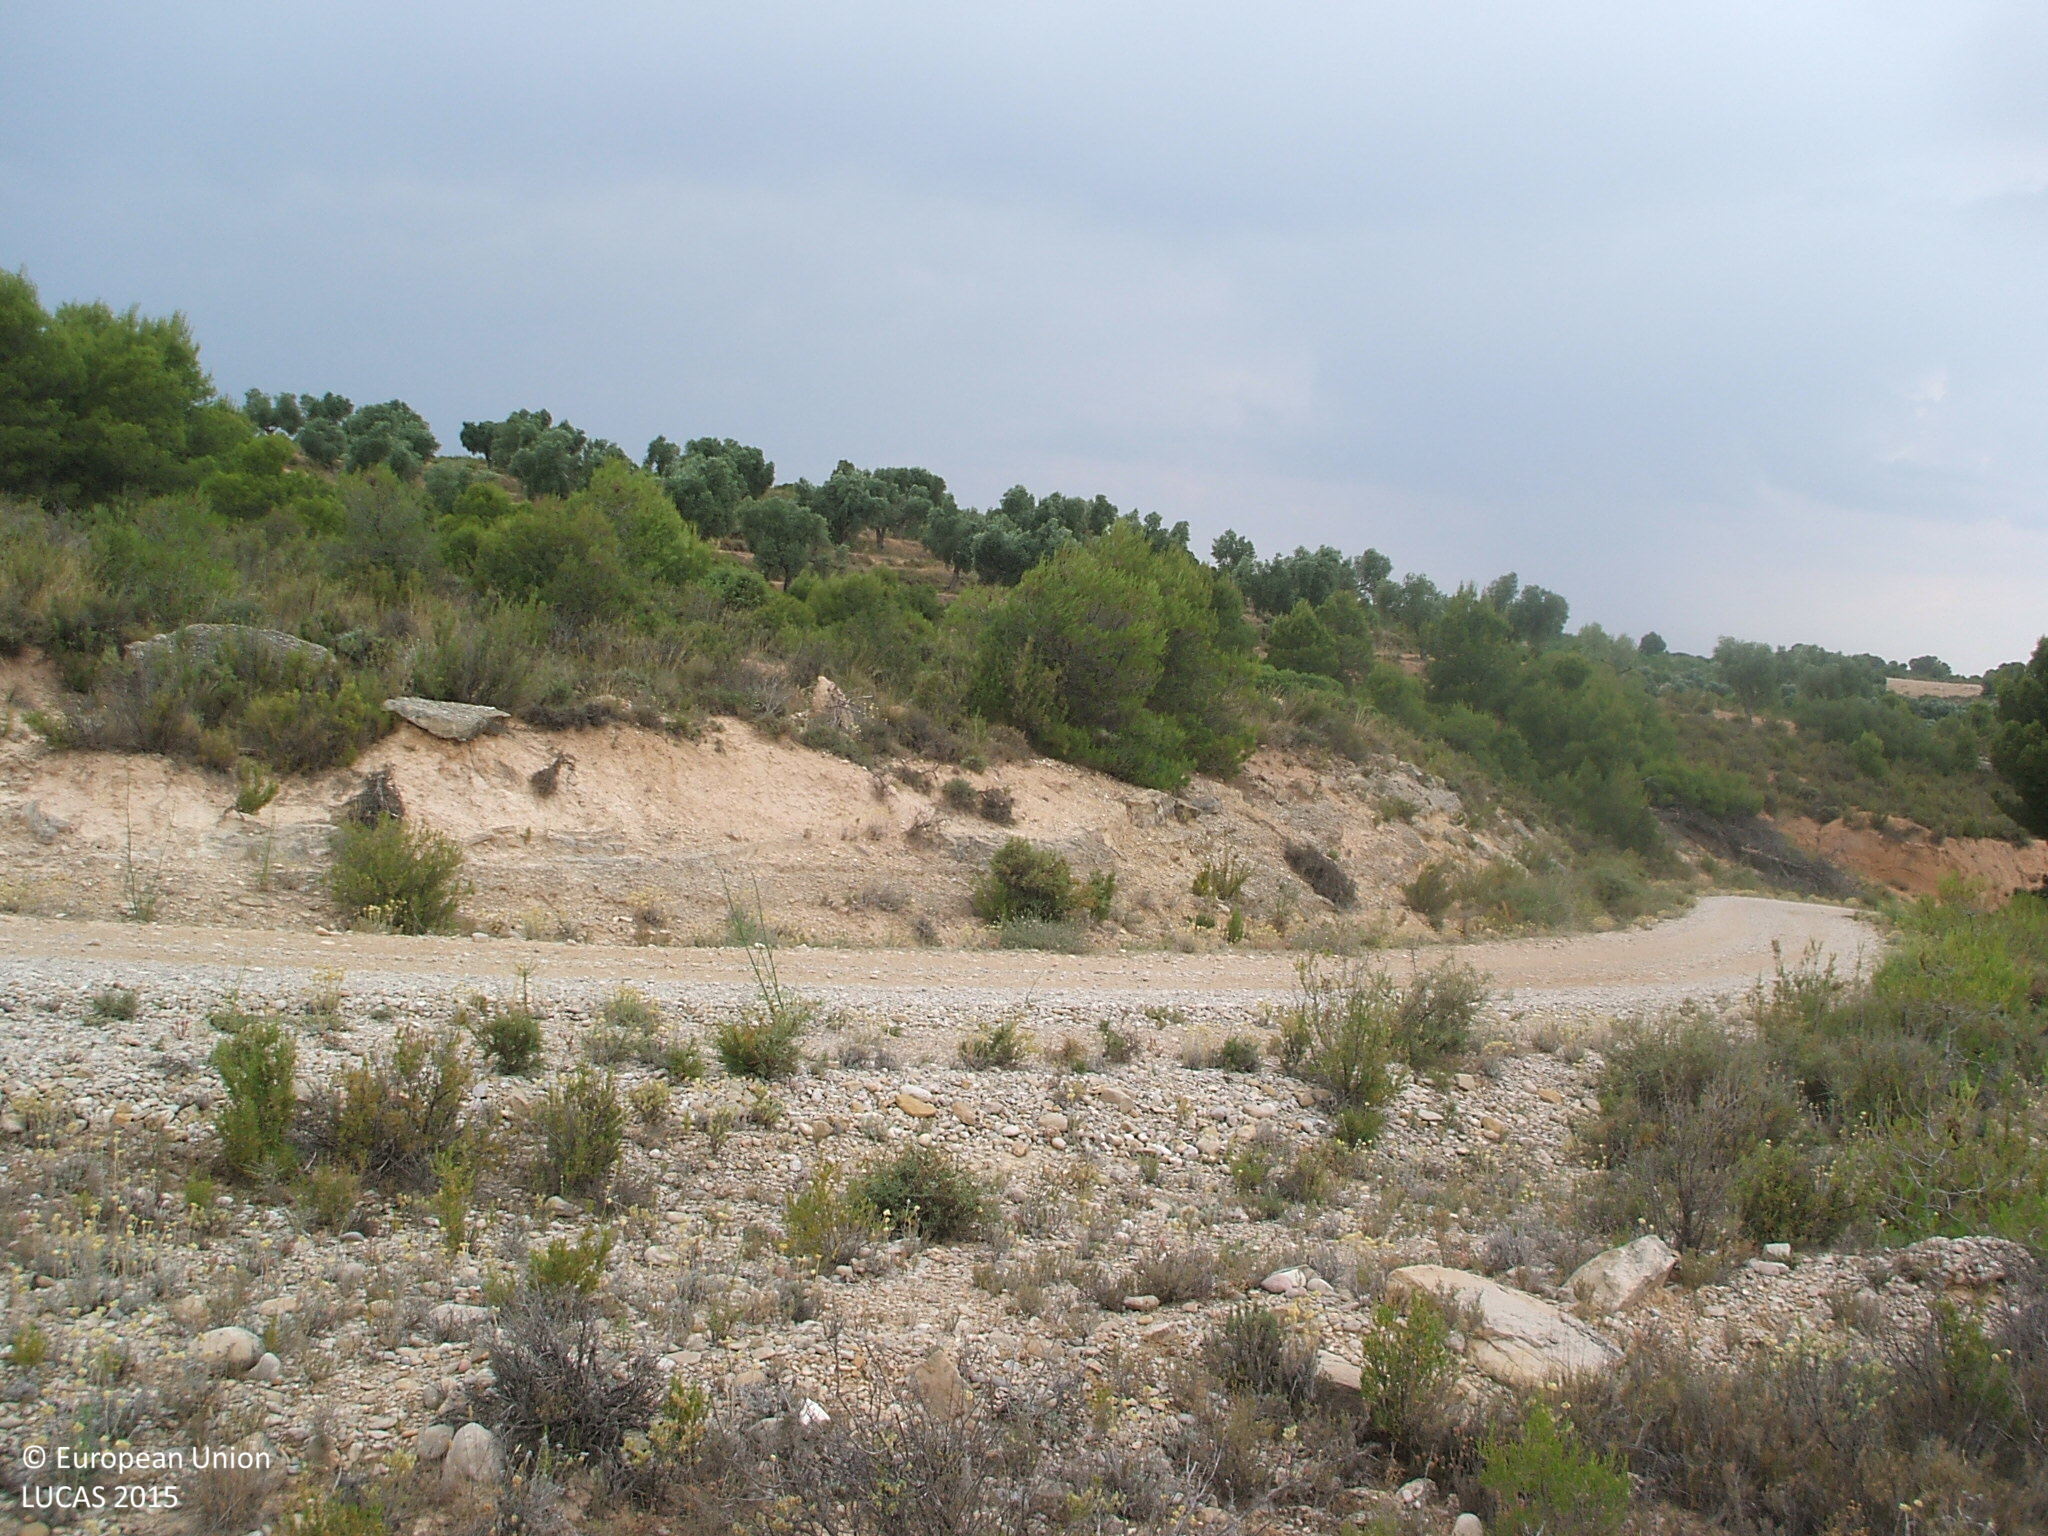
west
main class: Shrubland
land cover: Shrubland with sparse tree cover
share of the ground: > 75 %
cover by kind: shrubs 95 %, coniferous forest trees 5 %
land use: Semi-natural and natural areas not in use
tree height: > 5 m
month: June
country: ES
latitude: 41.0239
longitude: -0.0602
